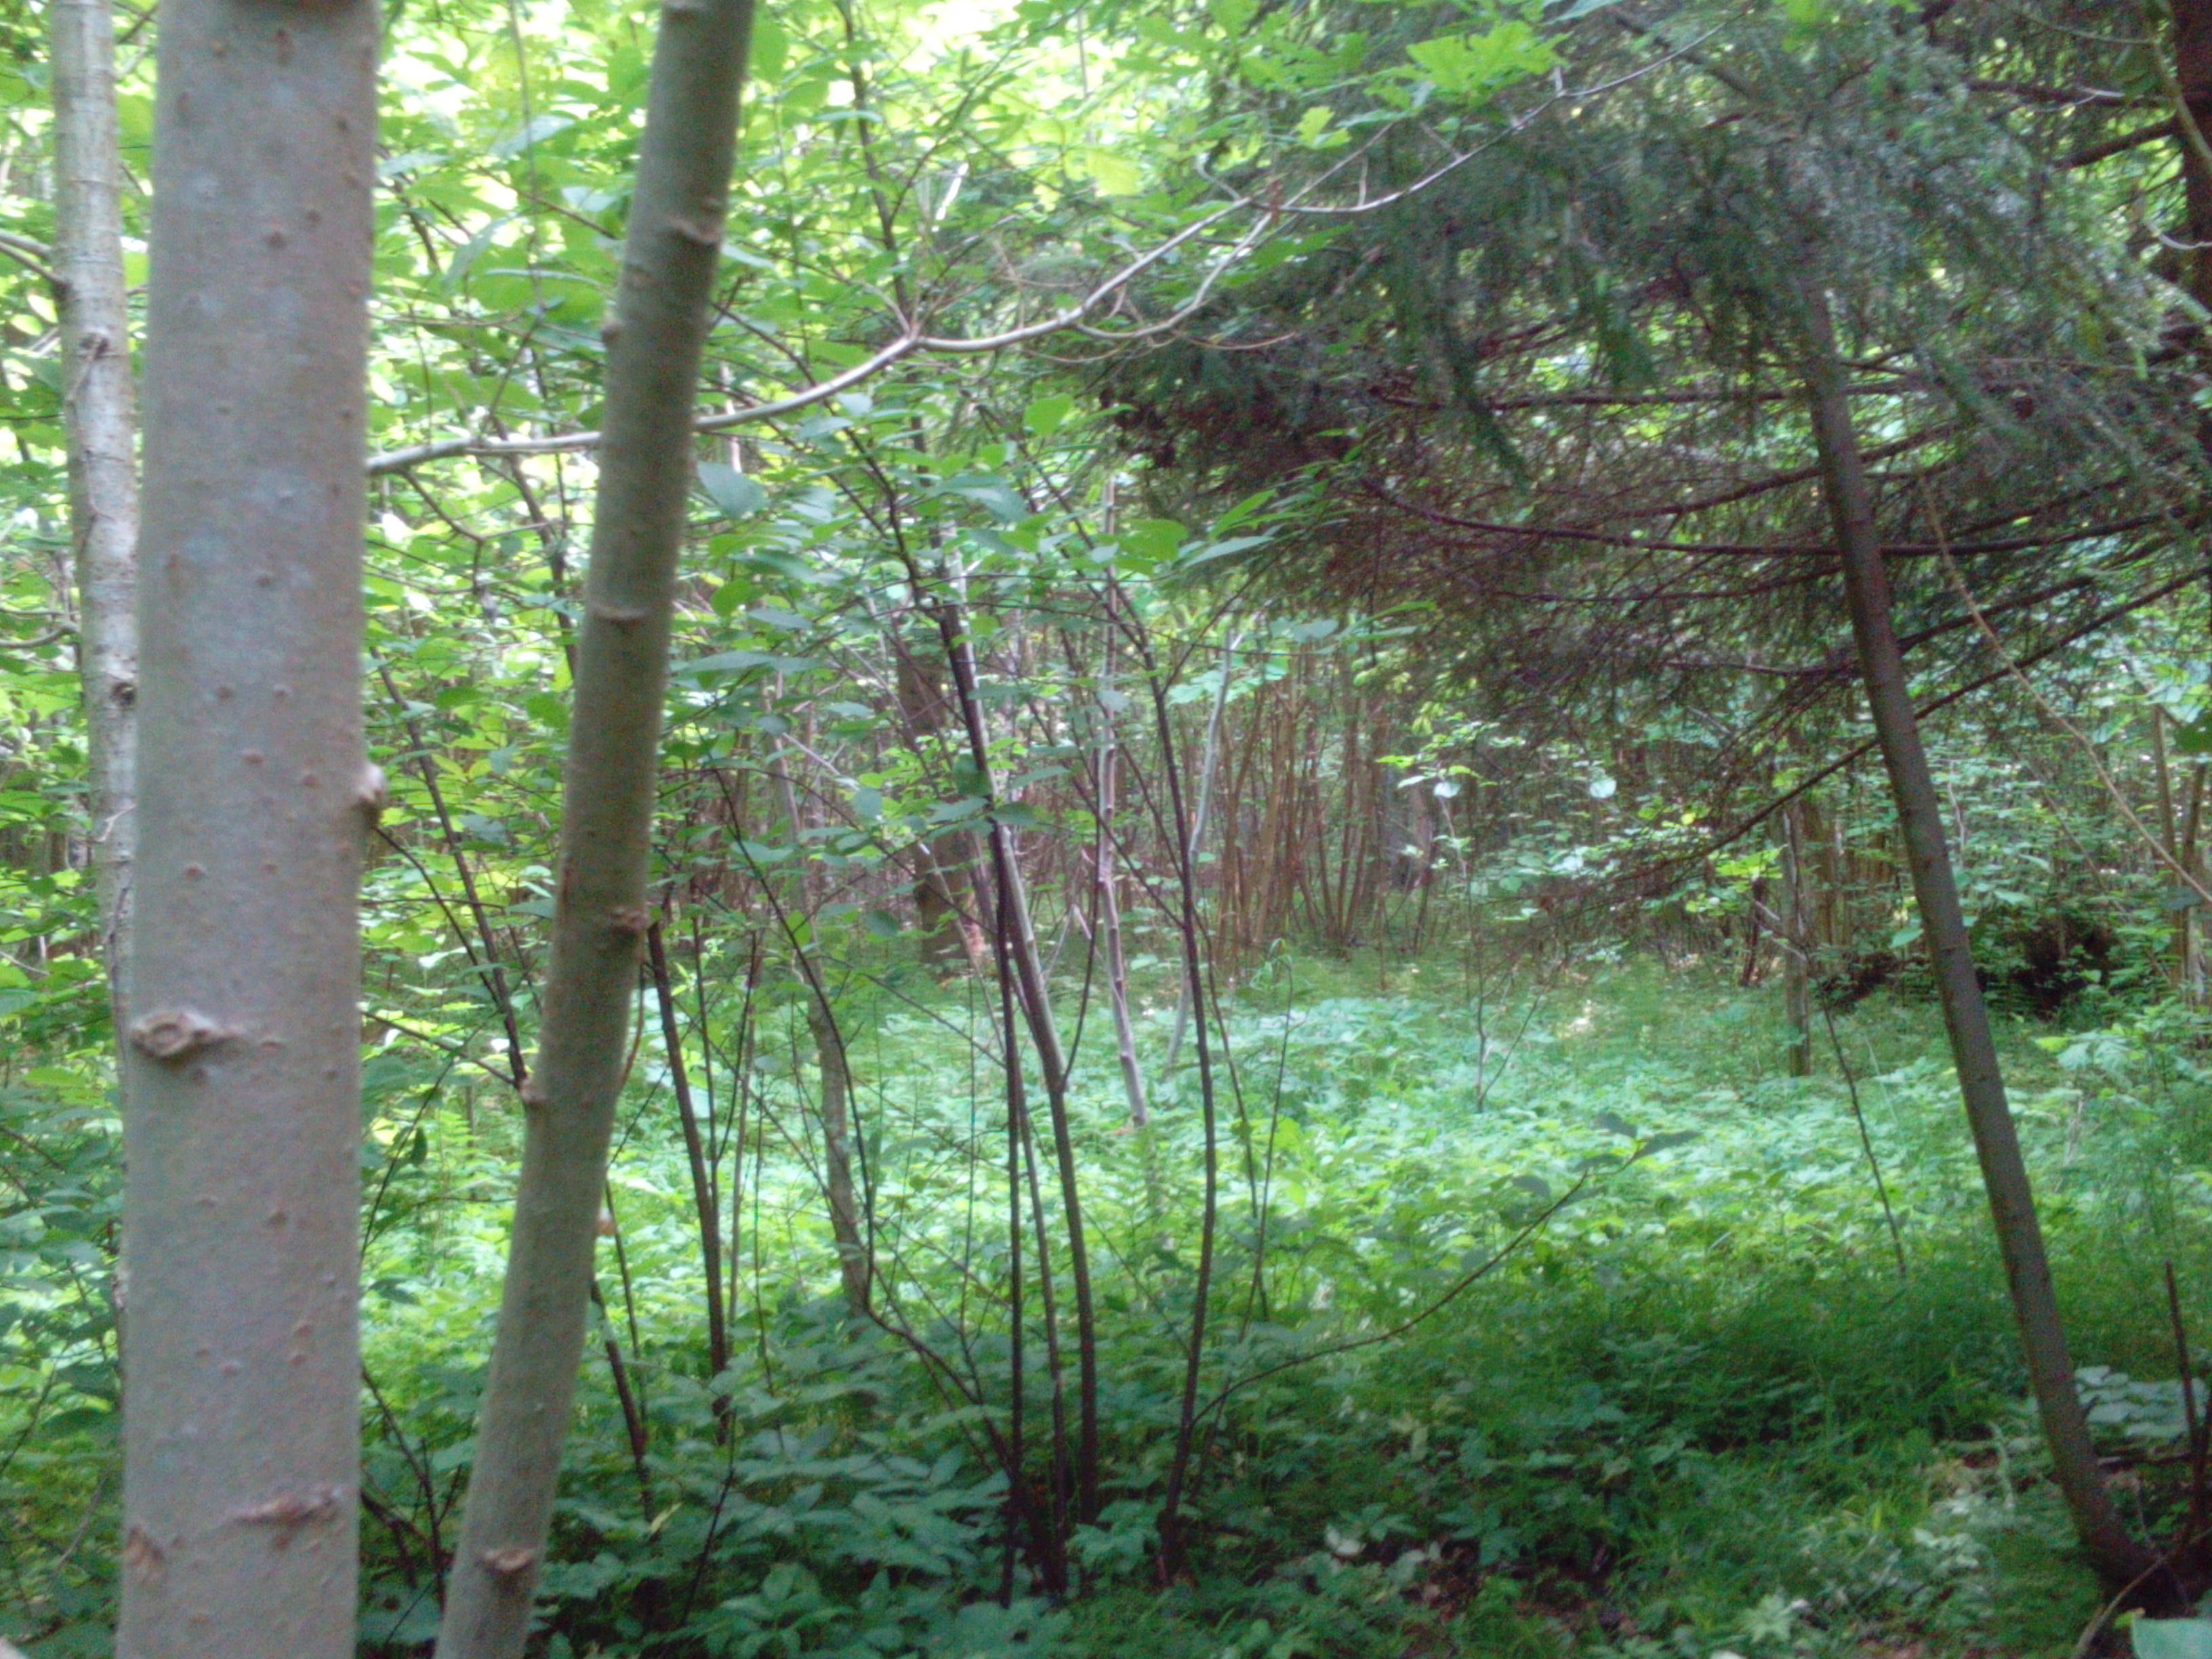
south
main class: Woodland
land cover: Spruce dominated mixed woodland
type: hemiboreal forest and nemoral coniferous forest and mixed broadleaved-coniferous forest
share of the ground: > 75 %
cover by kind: broadleaved forest trees 65 %, coniferous forest trees 35 %
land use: Forestry
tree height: > 5 m
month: June
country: LV
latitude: 56.8530
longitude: 22.2686
